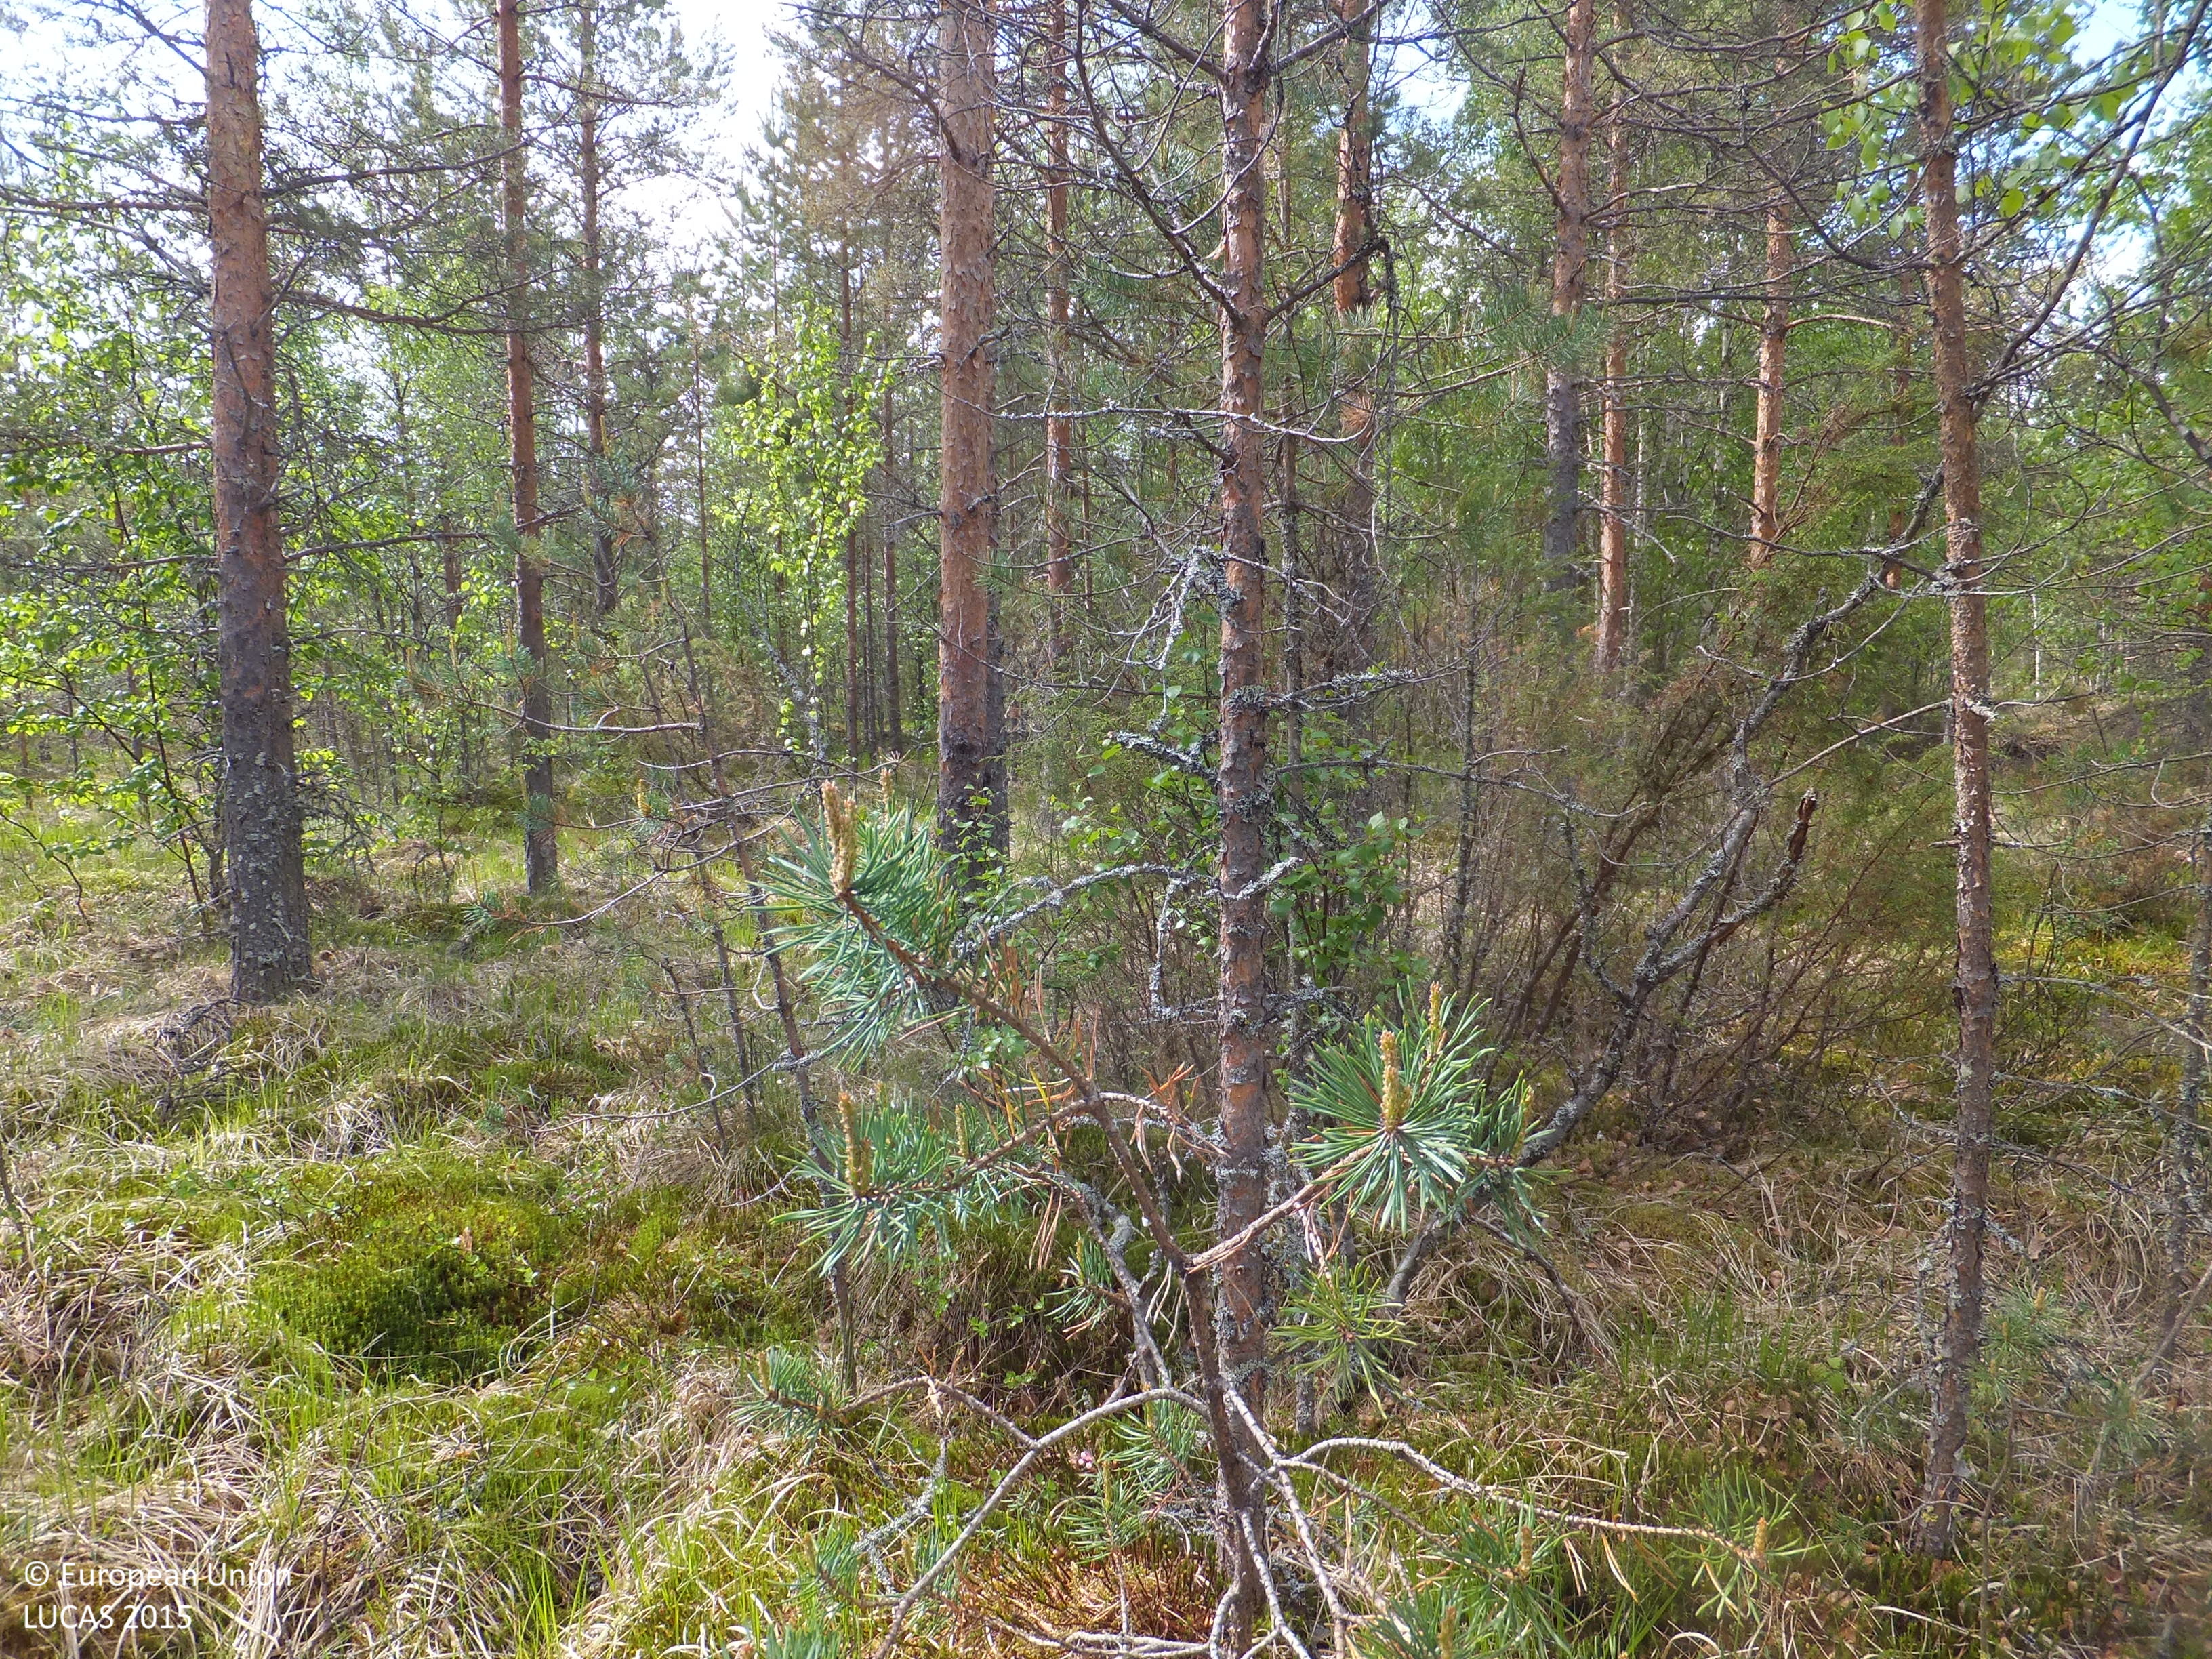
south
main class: Woodland
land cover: Pine dominated mixed woodland
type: boreal forest
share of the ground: 50 - 75 %
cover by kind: coniferous forest trees 30 %, broadleaved forest trees 30 %, herbaceous plants 15 %, lichens and mosses 15 %, shrubs 10 %
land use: Forestry
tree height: > 5 m
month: June
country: FI
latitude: 63.5906
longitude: 24.7751
